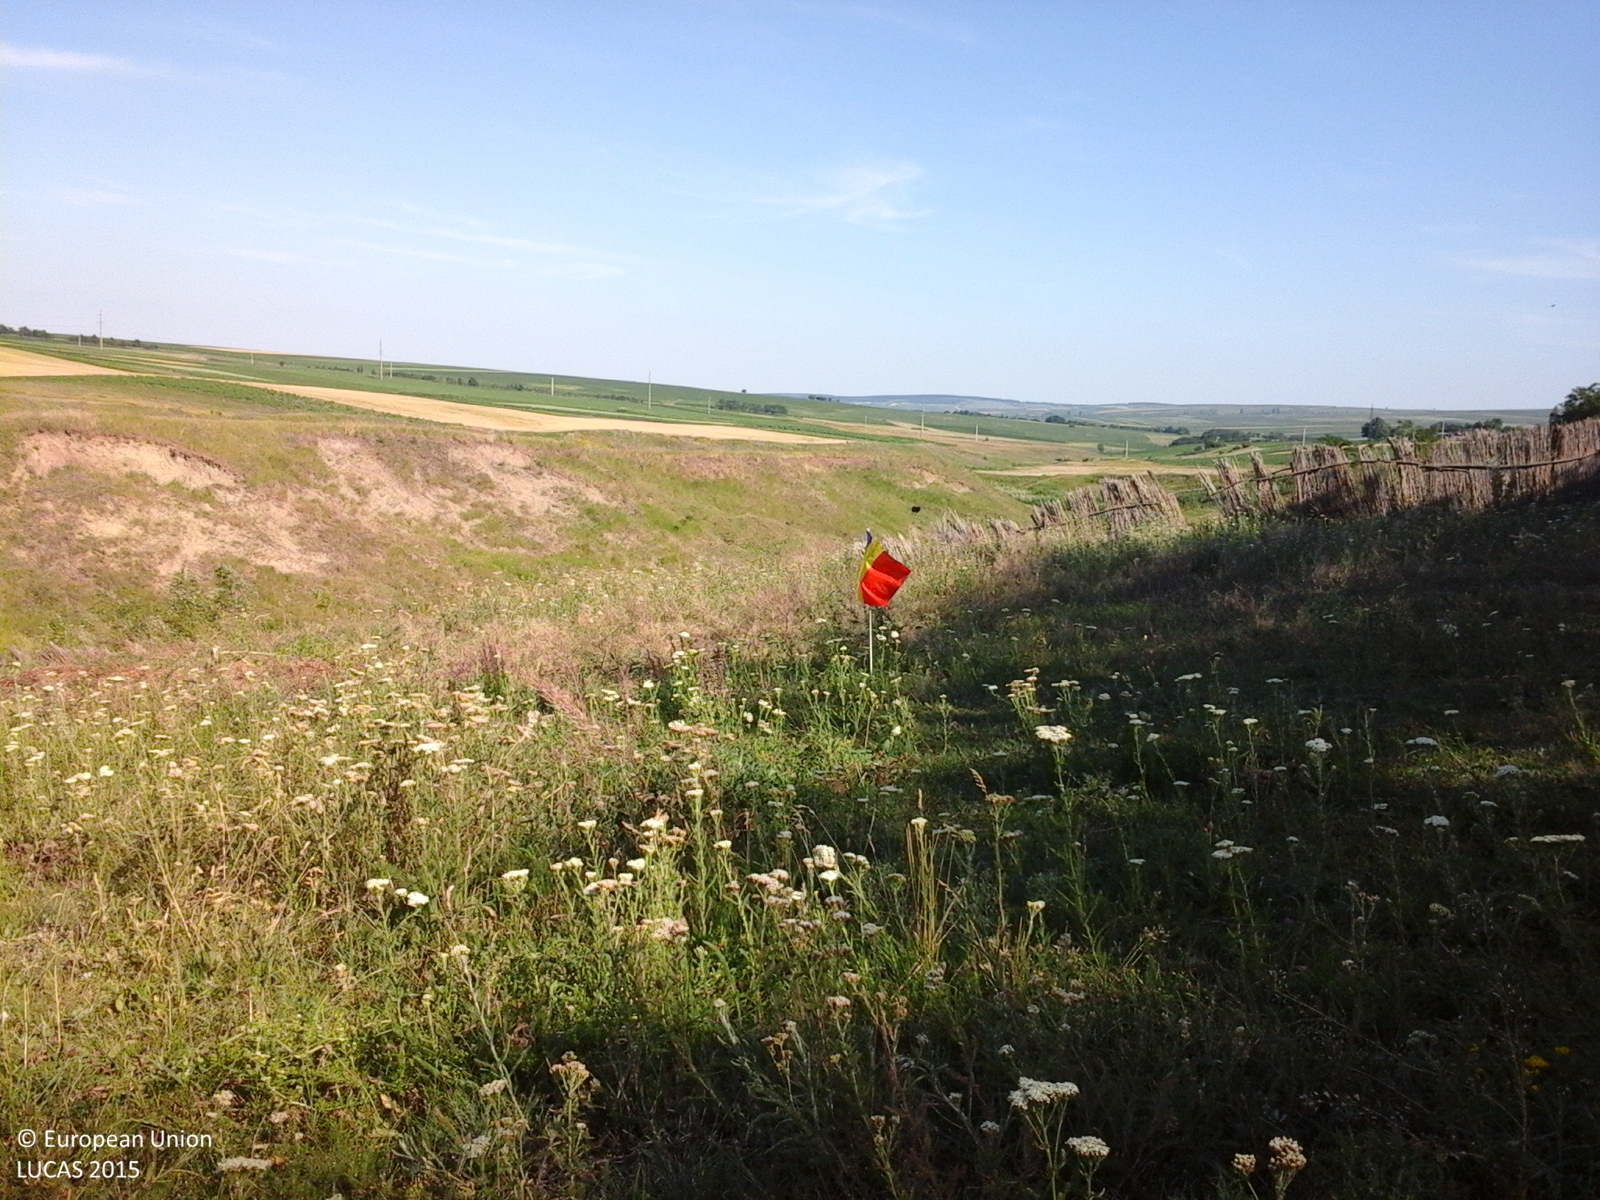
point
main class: Grassland
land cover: Grassland without tree/shrub cover
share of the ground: > 75 %
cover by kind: herbaceous plants 100 %
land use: Agriculture (excluding fallow land and kitchen gardens)
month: June
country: RO
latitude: 48.0532
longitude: 26.9702
